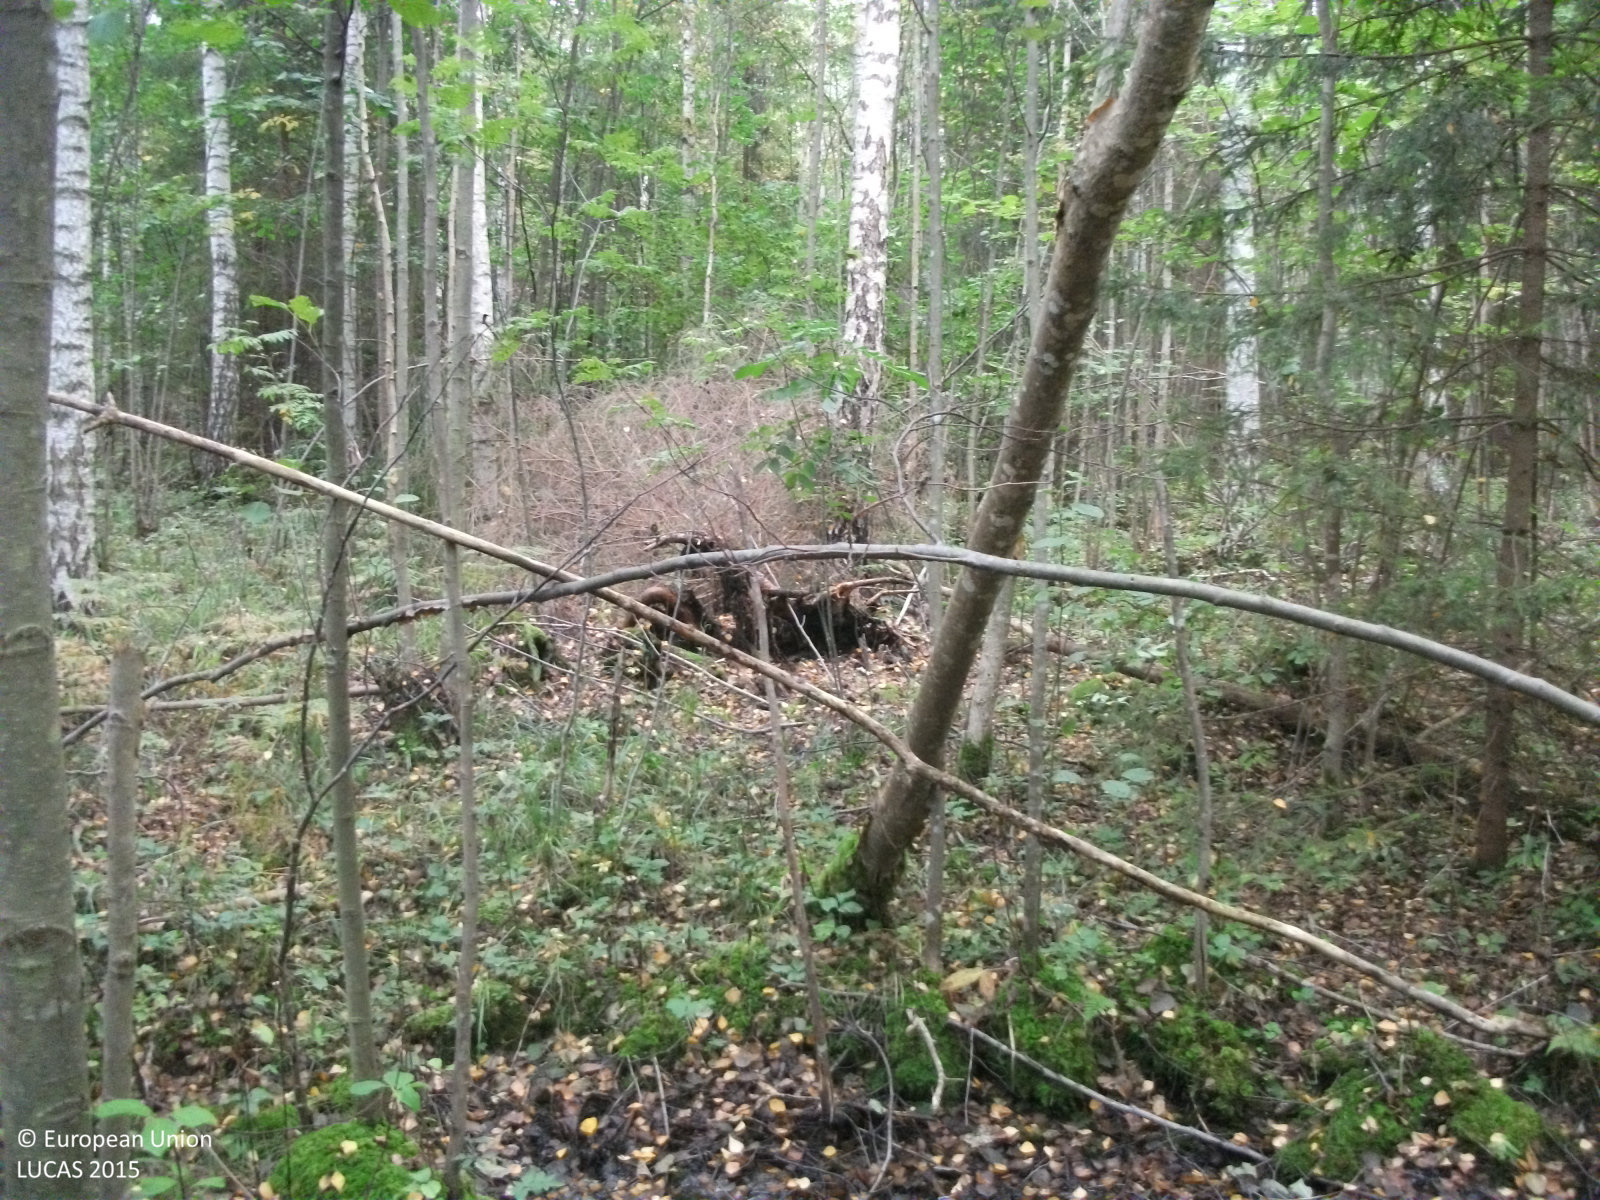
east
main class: Woodland
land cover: Broadleaved woodland
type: non-riverine alder, birch or aspen forest
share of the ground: > 75 %
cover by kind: broadleaved forest trees 85 %, herbaceous plants 10 %, shrubs 5 %
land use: Forestry
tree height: > 5 m
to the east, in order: Broadleaved woodland; Spruce dominated coniferous woodland; Spruce dominated mixed woodland; Broadleaved woodland
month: September
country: LV
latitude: 57.7088
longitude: 24.4381
